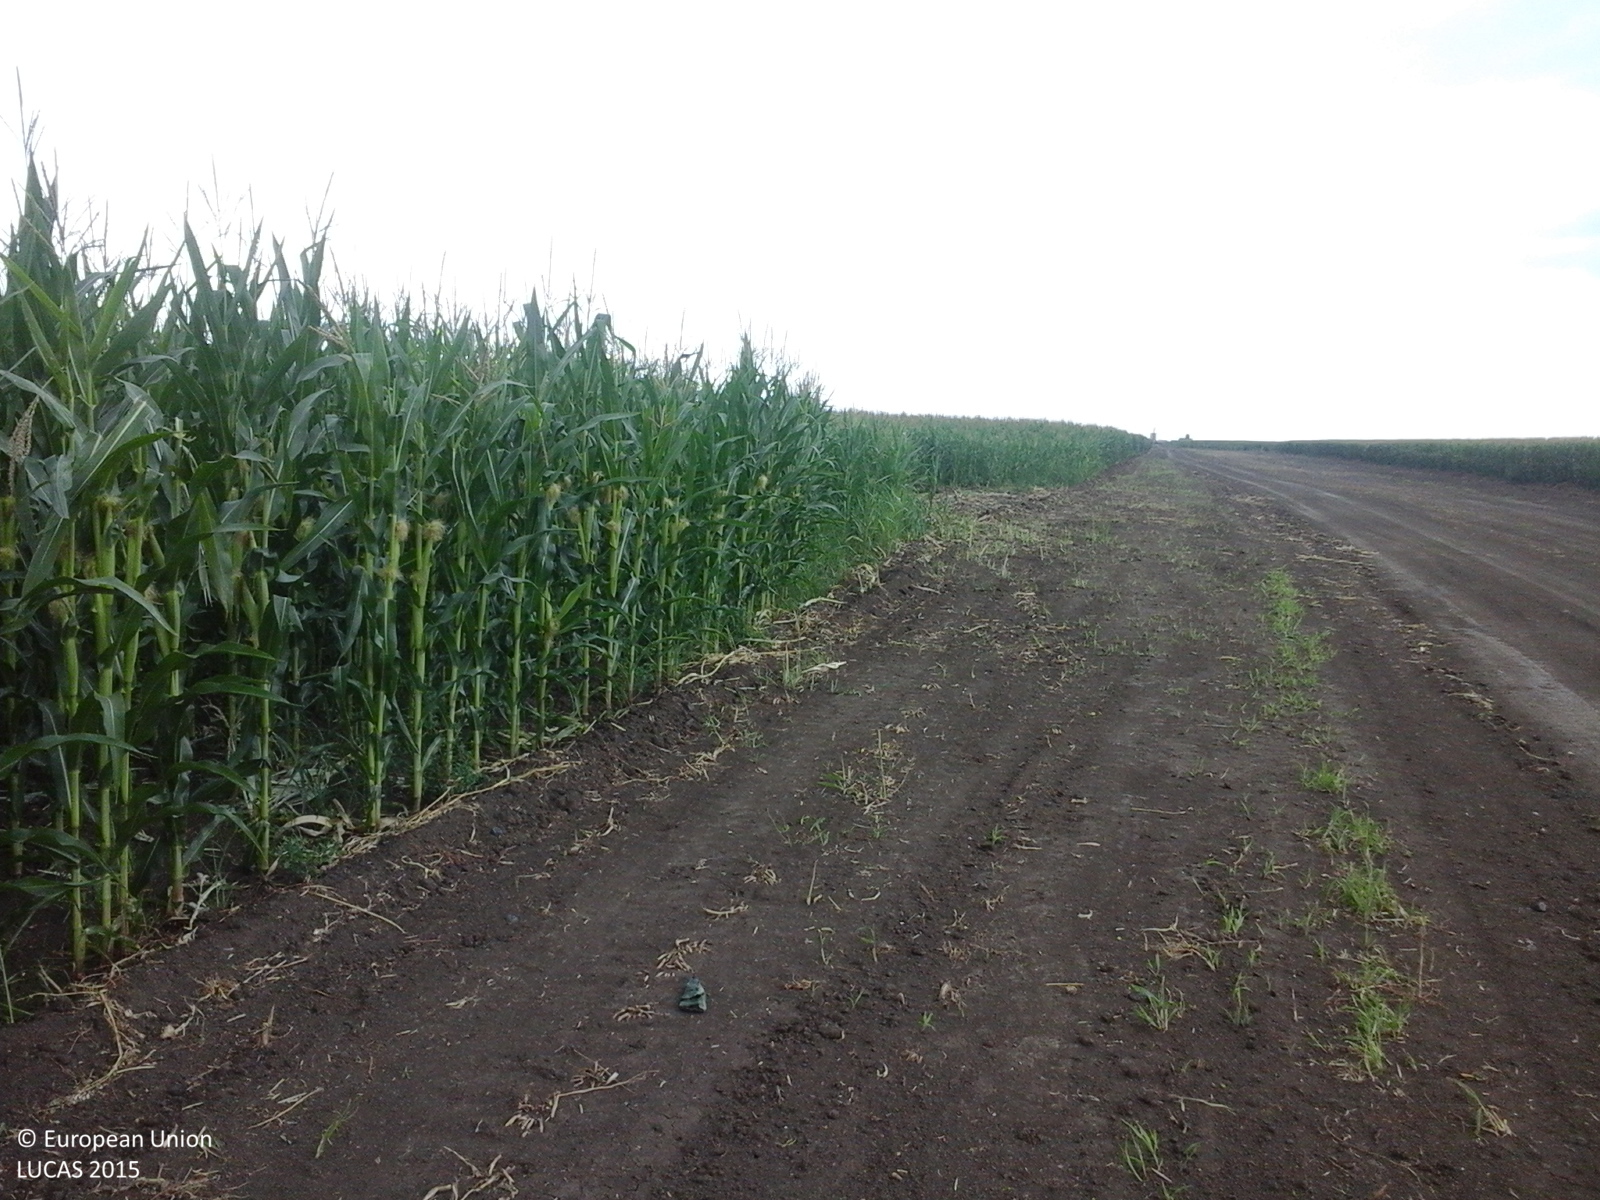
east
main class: Cropland
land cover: Maize
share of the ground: > 75 %
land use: Agriculture (excluding fallow land and kitchen gardens)
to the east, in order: Maize
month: July
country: RO
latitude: 43.8401
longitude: 25.2410
